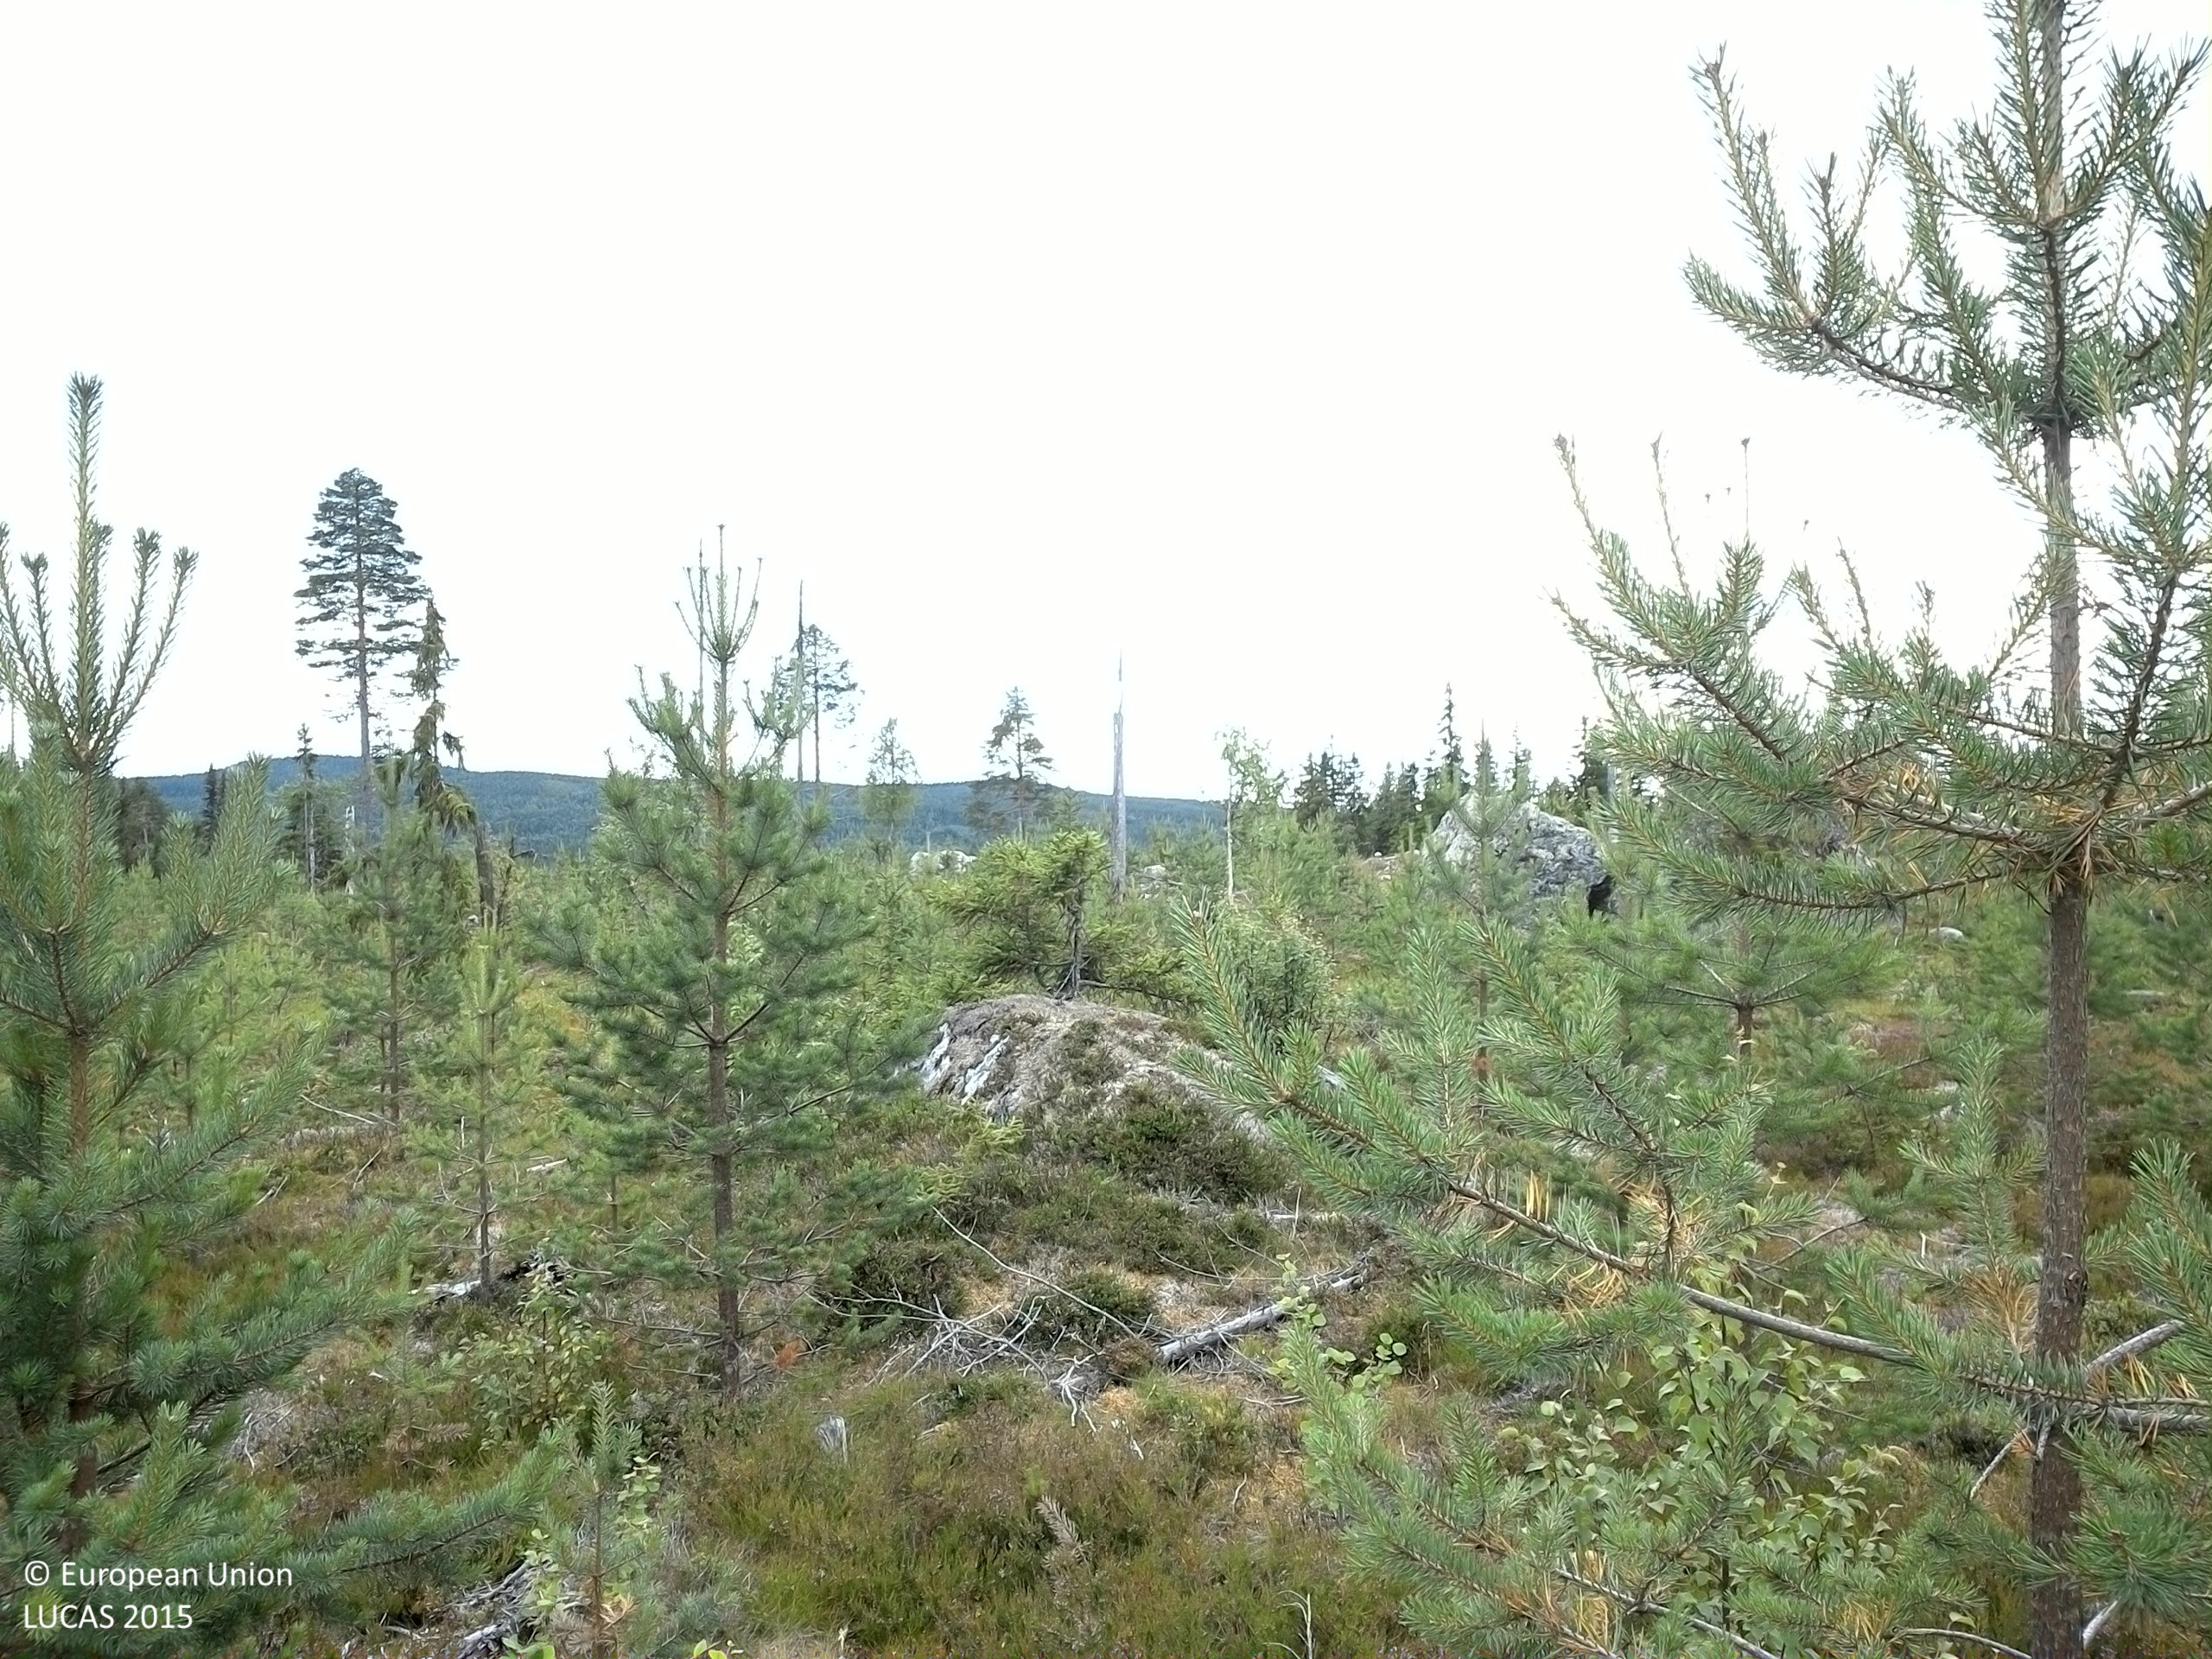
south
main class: Woodland
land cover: Pine dominated mixed woodland
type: boreal forest
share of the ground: 25 - 50 %
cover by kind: shrubs 45 %, coniferous forest trees 20 %, herbaceous plants 15 %, broadleaved forest trees 10 %, lichens and mosses 10 %
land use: Forestry
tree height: < 5 m
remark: Clear cut
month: August
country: SE
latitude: 63.7015
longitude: 18.0859
